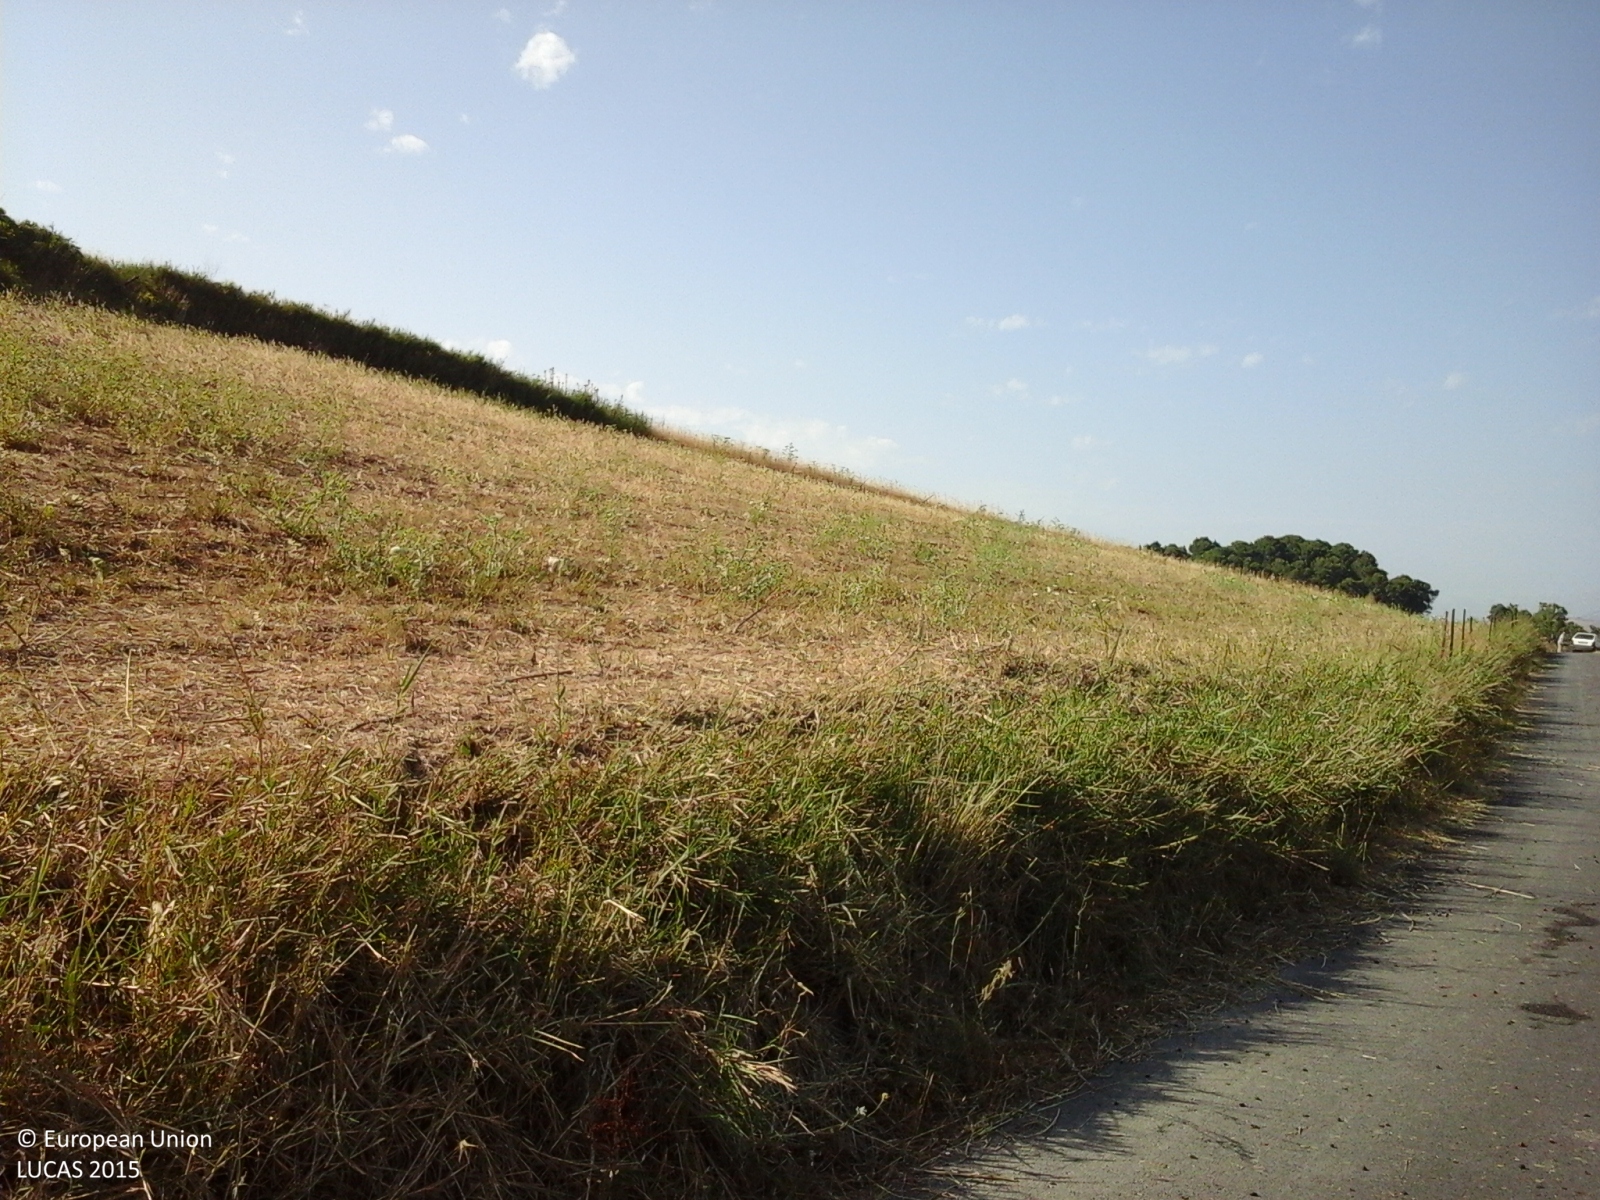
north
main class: Grassland
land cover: Grassland without tree/shrub cover
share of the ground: > 75 %
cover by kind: herbaceous plants 100 %
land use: Agriculture (excluding fallow land and kitchen gardens)
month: June
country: IT
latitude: 37.7775
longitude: 12.8513
